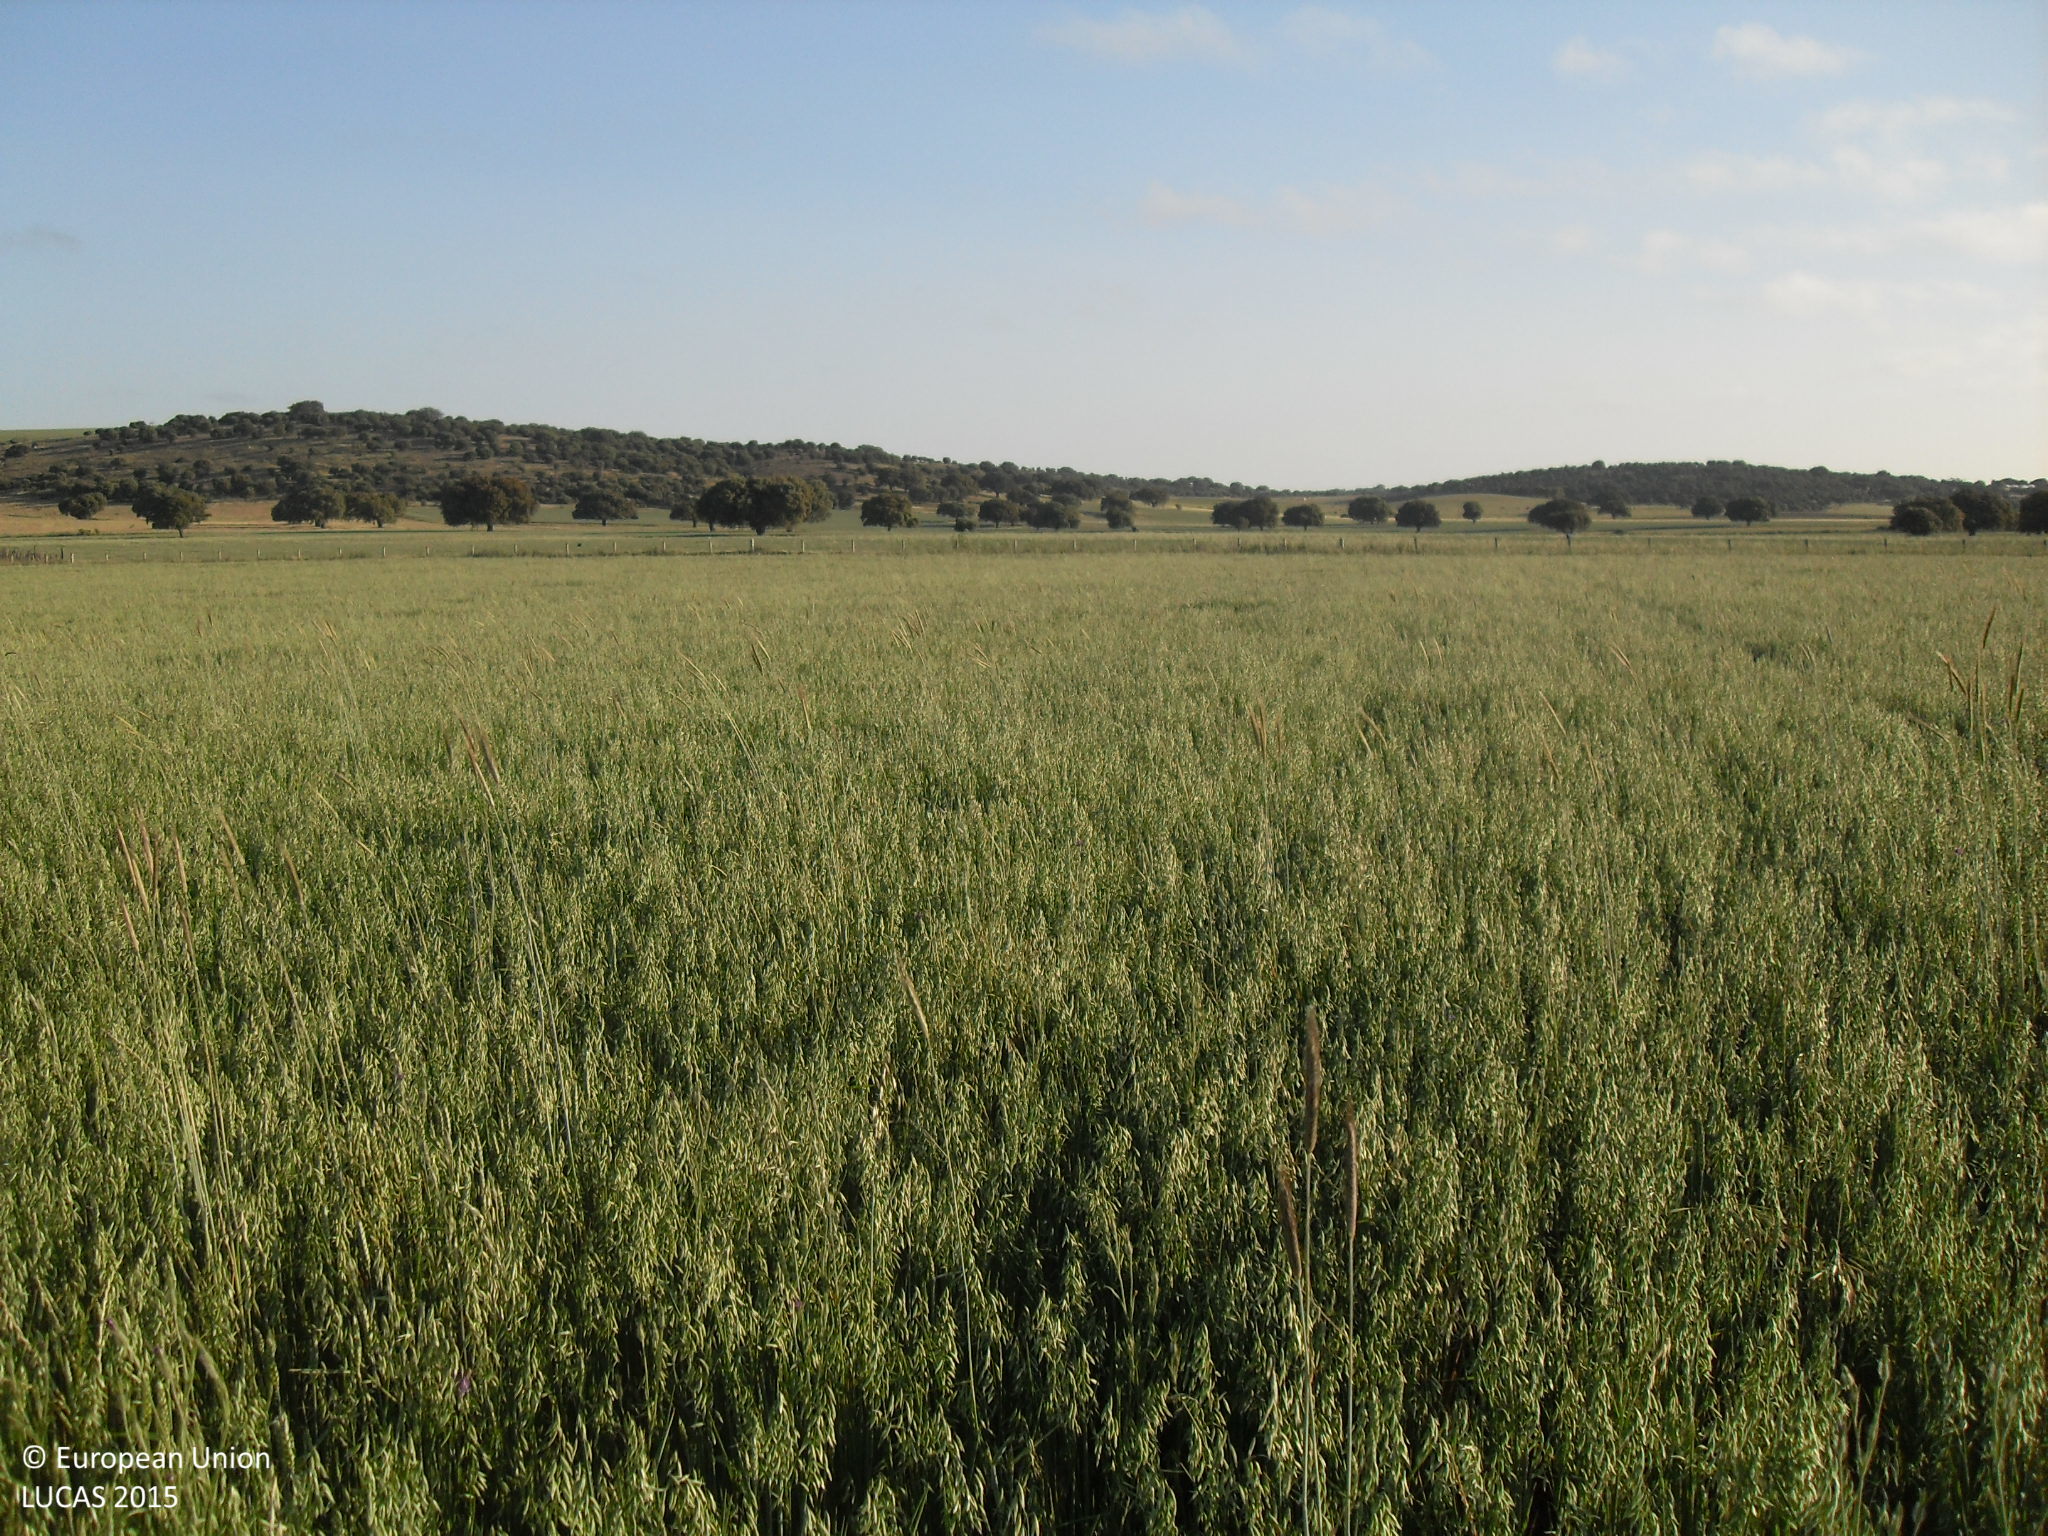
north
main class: Cropland
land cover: Oats
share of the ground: > 75 %
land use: Agriculture (excluding fallow land and kitchen gardens)
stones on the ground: < 10 %
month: May
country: ES
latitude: 40.7391
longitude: -5.5974
